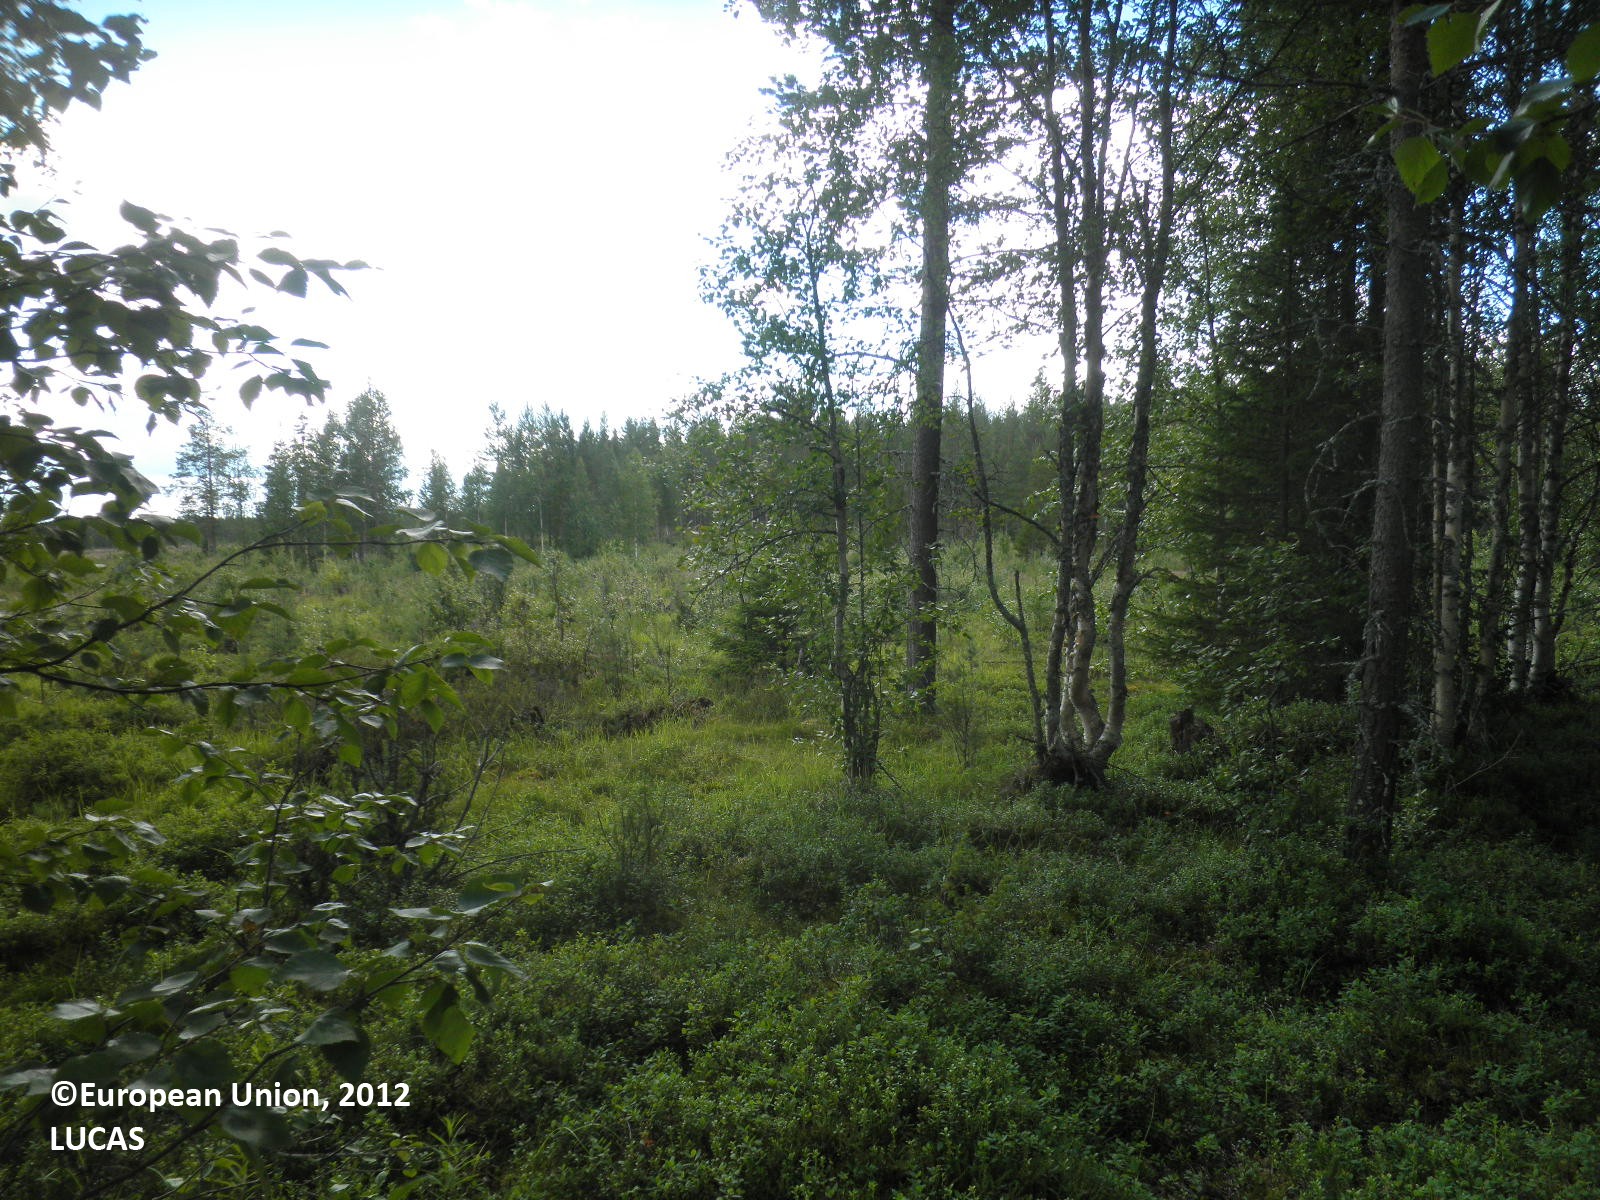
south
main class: Woodland
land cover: Pine dominated mixed woodland
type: boreal forest
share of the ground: 25 - 50 %
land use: Forestry
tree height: > 5 m
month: August
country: FI
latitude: 67.3968
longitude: 27.7566
